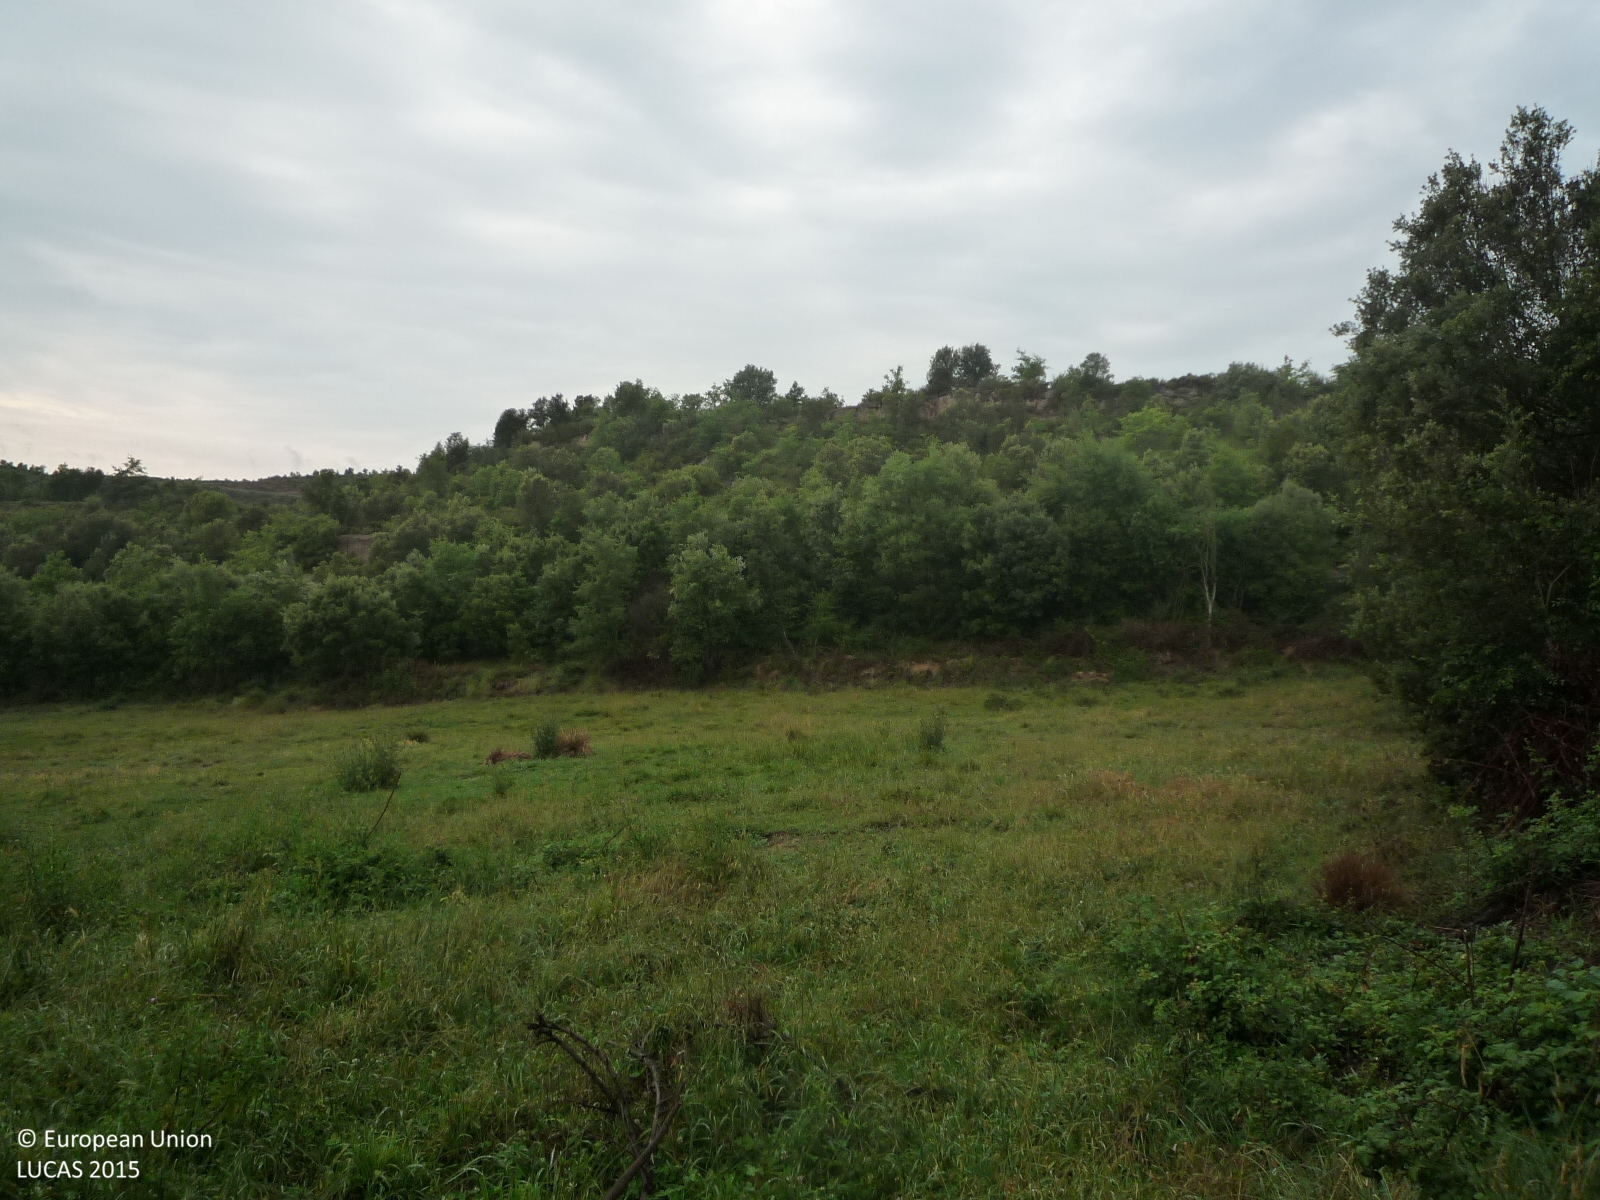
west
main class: Grassland
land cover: Grassland without tree/shrub cover
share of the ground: > 75 %
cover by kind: herbaceous plants 100 %
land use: Agriculture (excluding fallow land and kitchen gardens)
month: June
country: ES
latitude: 42.0254
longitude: 1.9579
